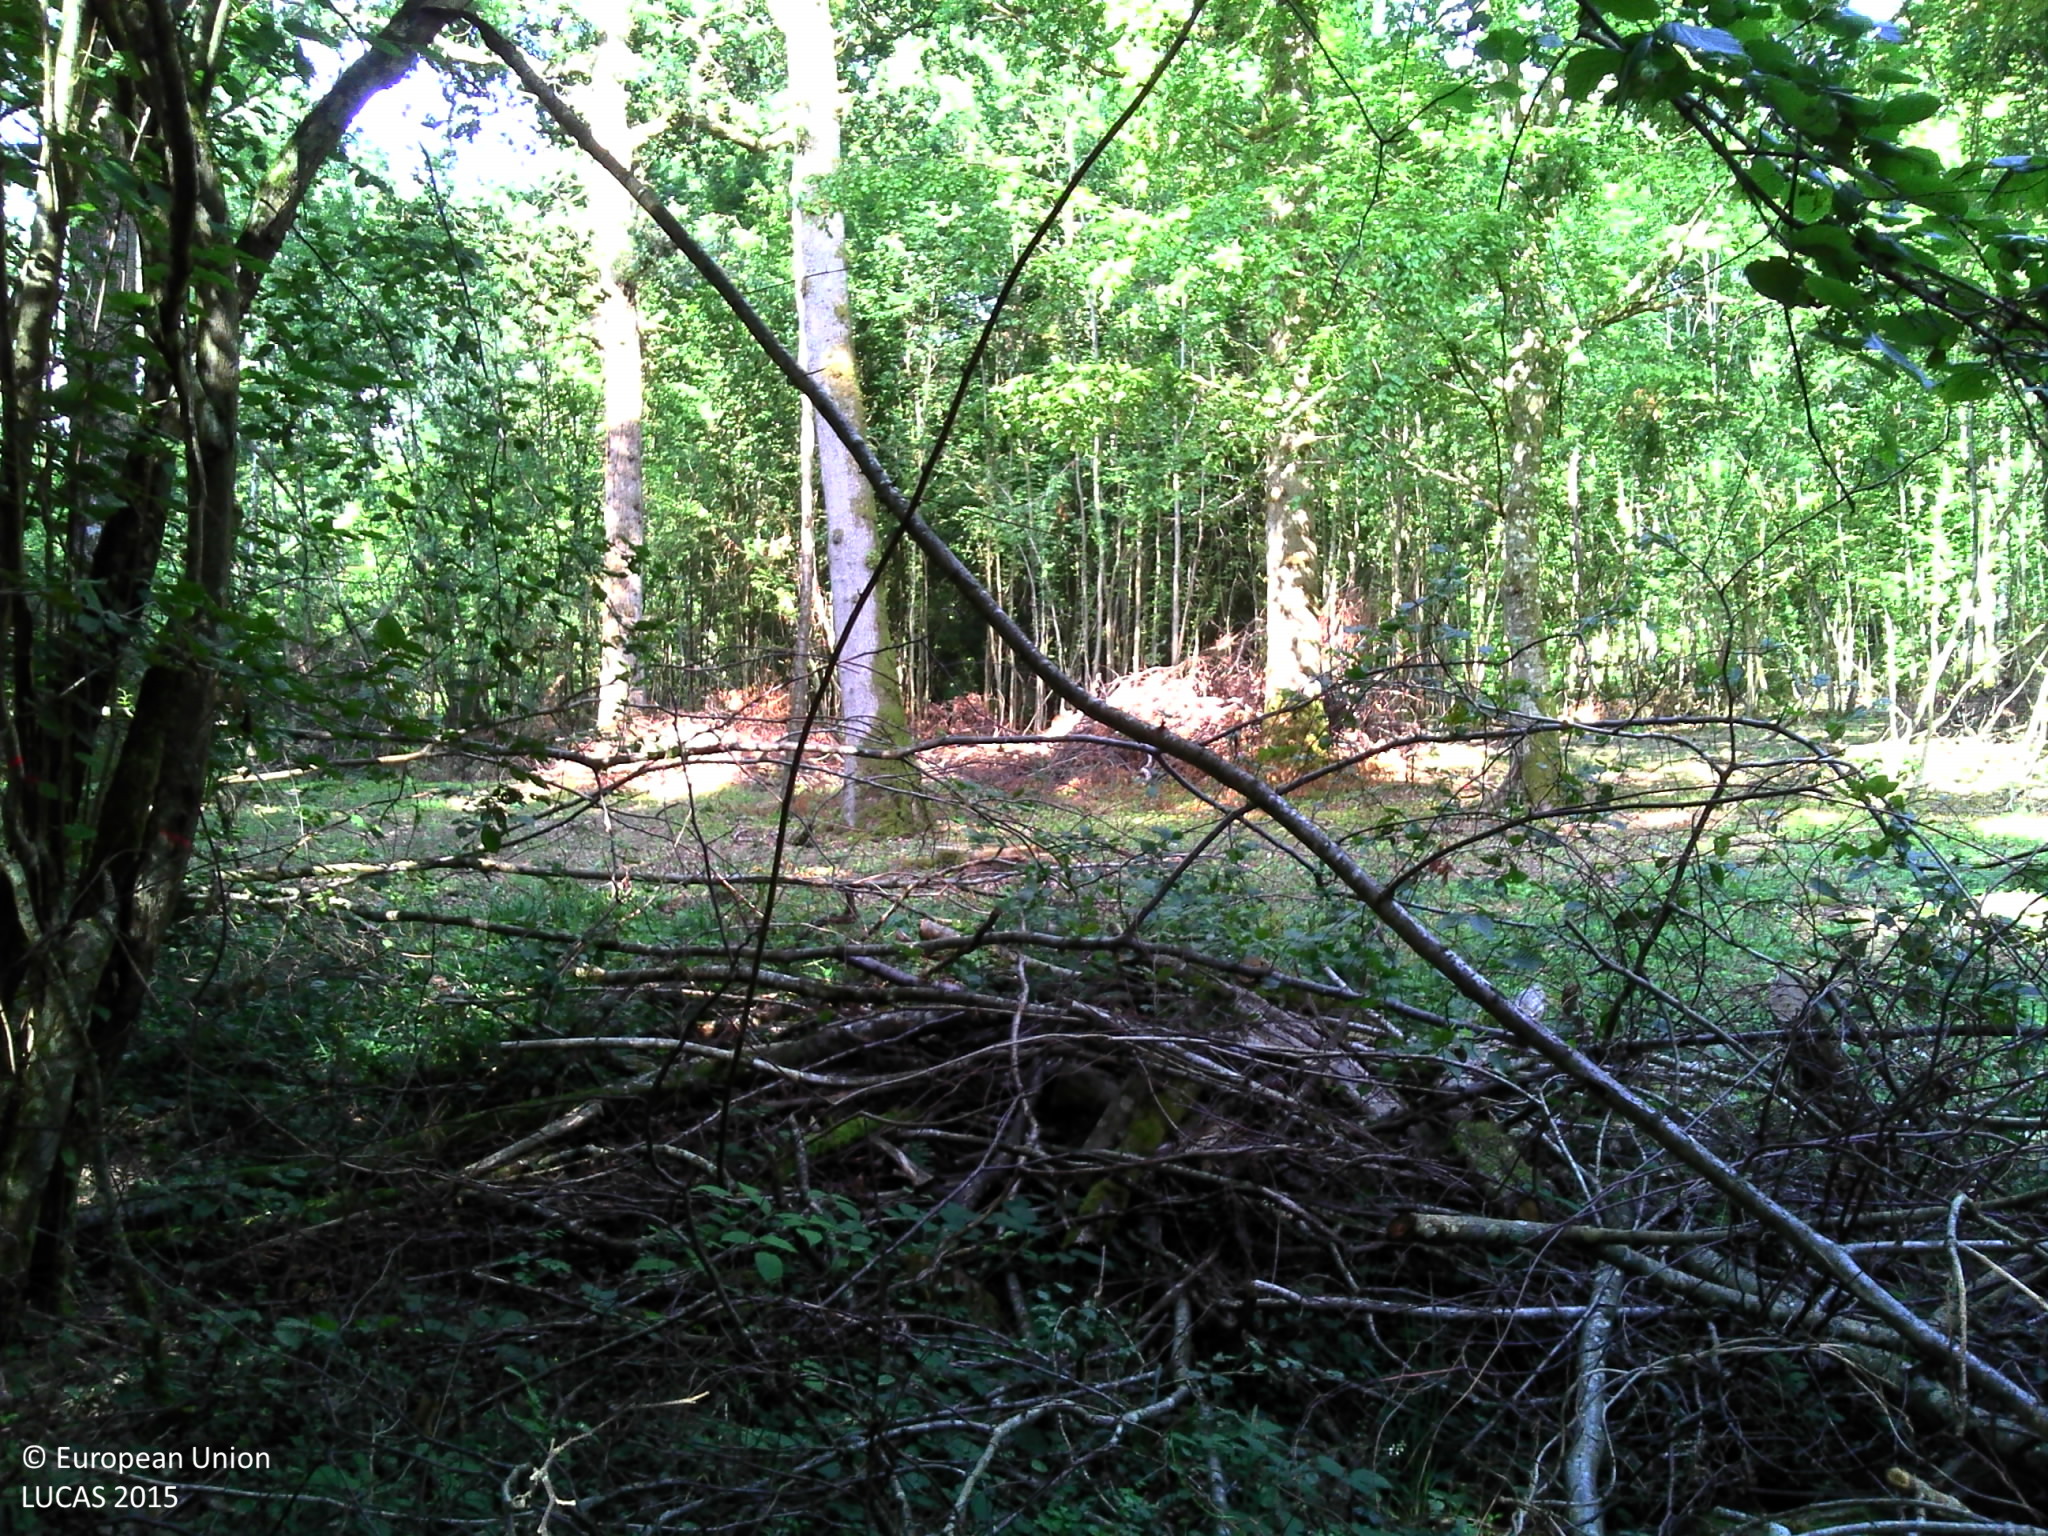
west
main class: Woodland
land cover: Broadleaved woodland
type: mesophytic deciduous forest
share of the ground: > 75 %
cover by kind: herbaceous plants 40 %, broadleaved forest trees 35 %, unconsolidated bare surface 15 %, lichens and mosses 5 %
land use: Forestry
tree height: > 5 m
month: August
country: FR
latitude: 49.0203
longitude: 3.7450
